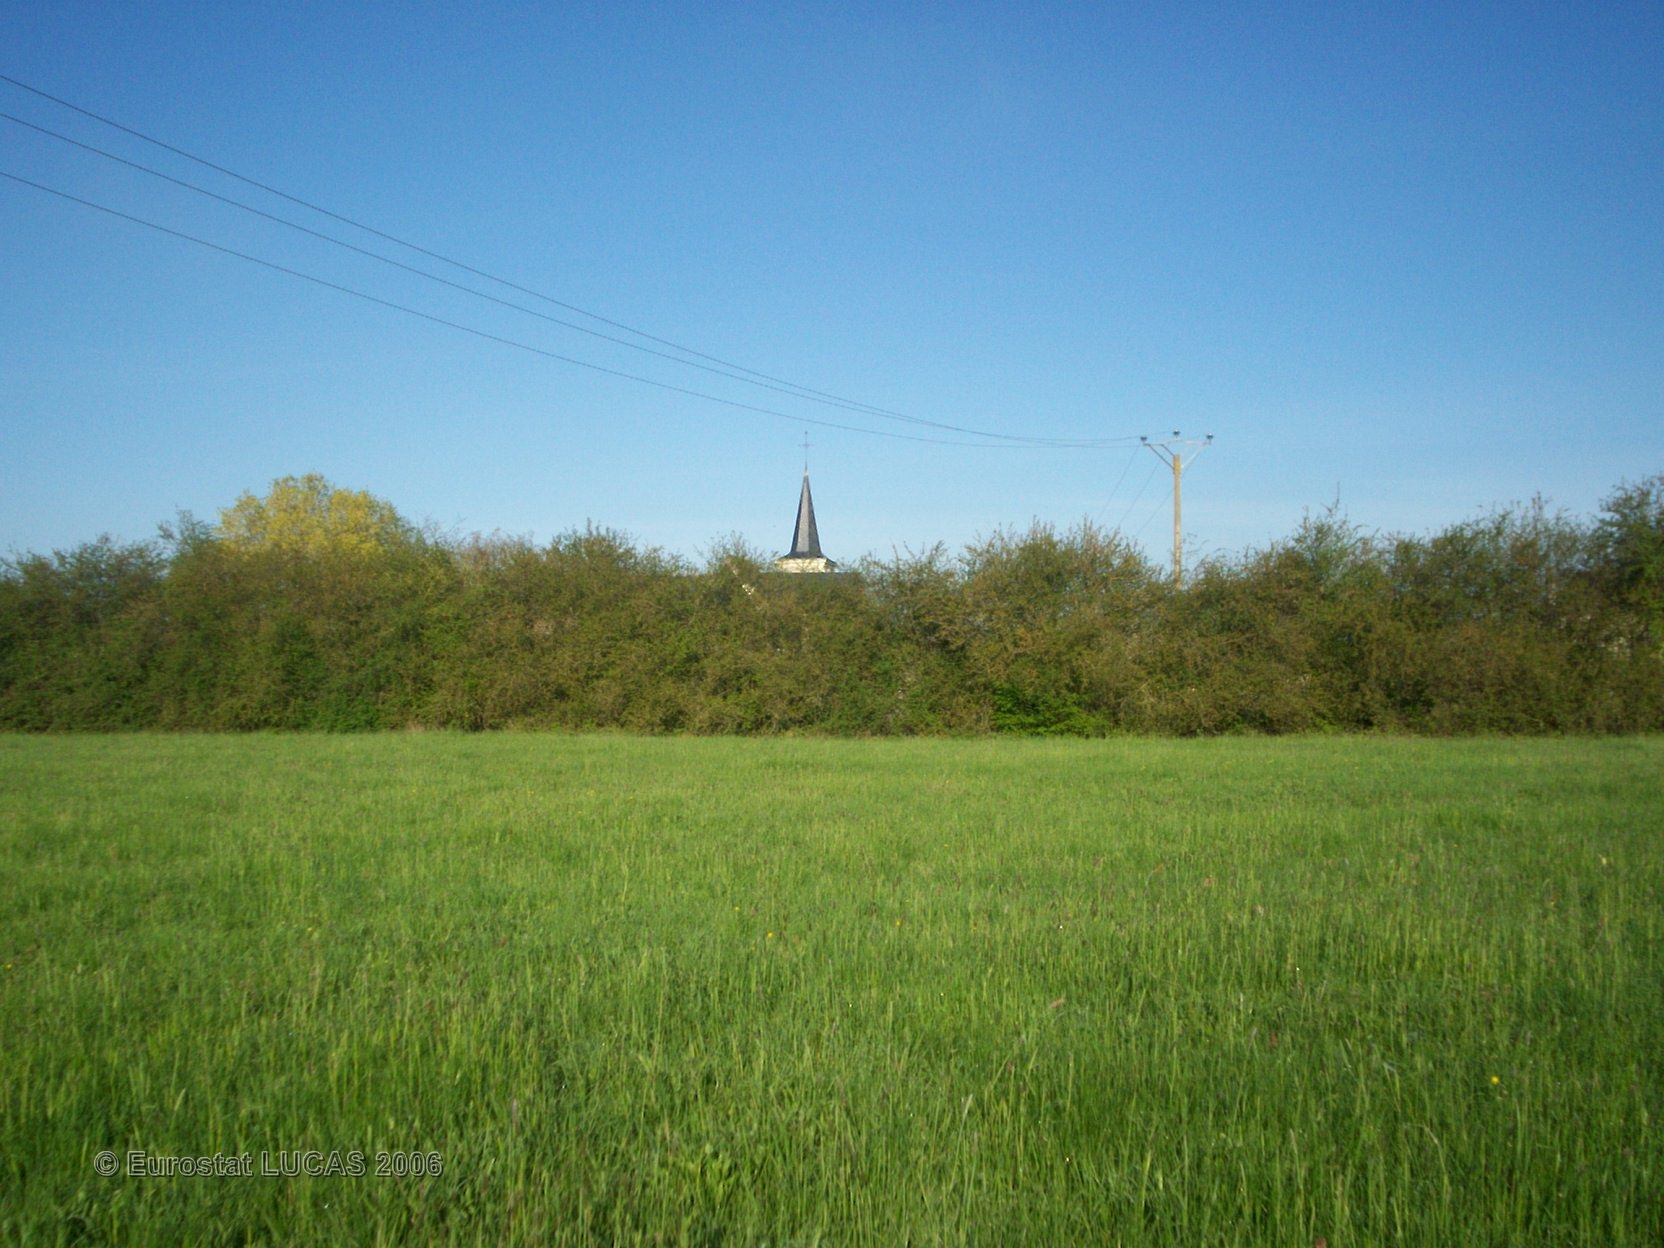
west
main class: Grassland
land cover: Grassland without tree/shrub cover
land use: Agriculture (excluding fallow land and kitchen gardens)
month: April
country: FR
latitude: 47.4922
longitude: -0.4231
